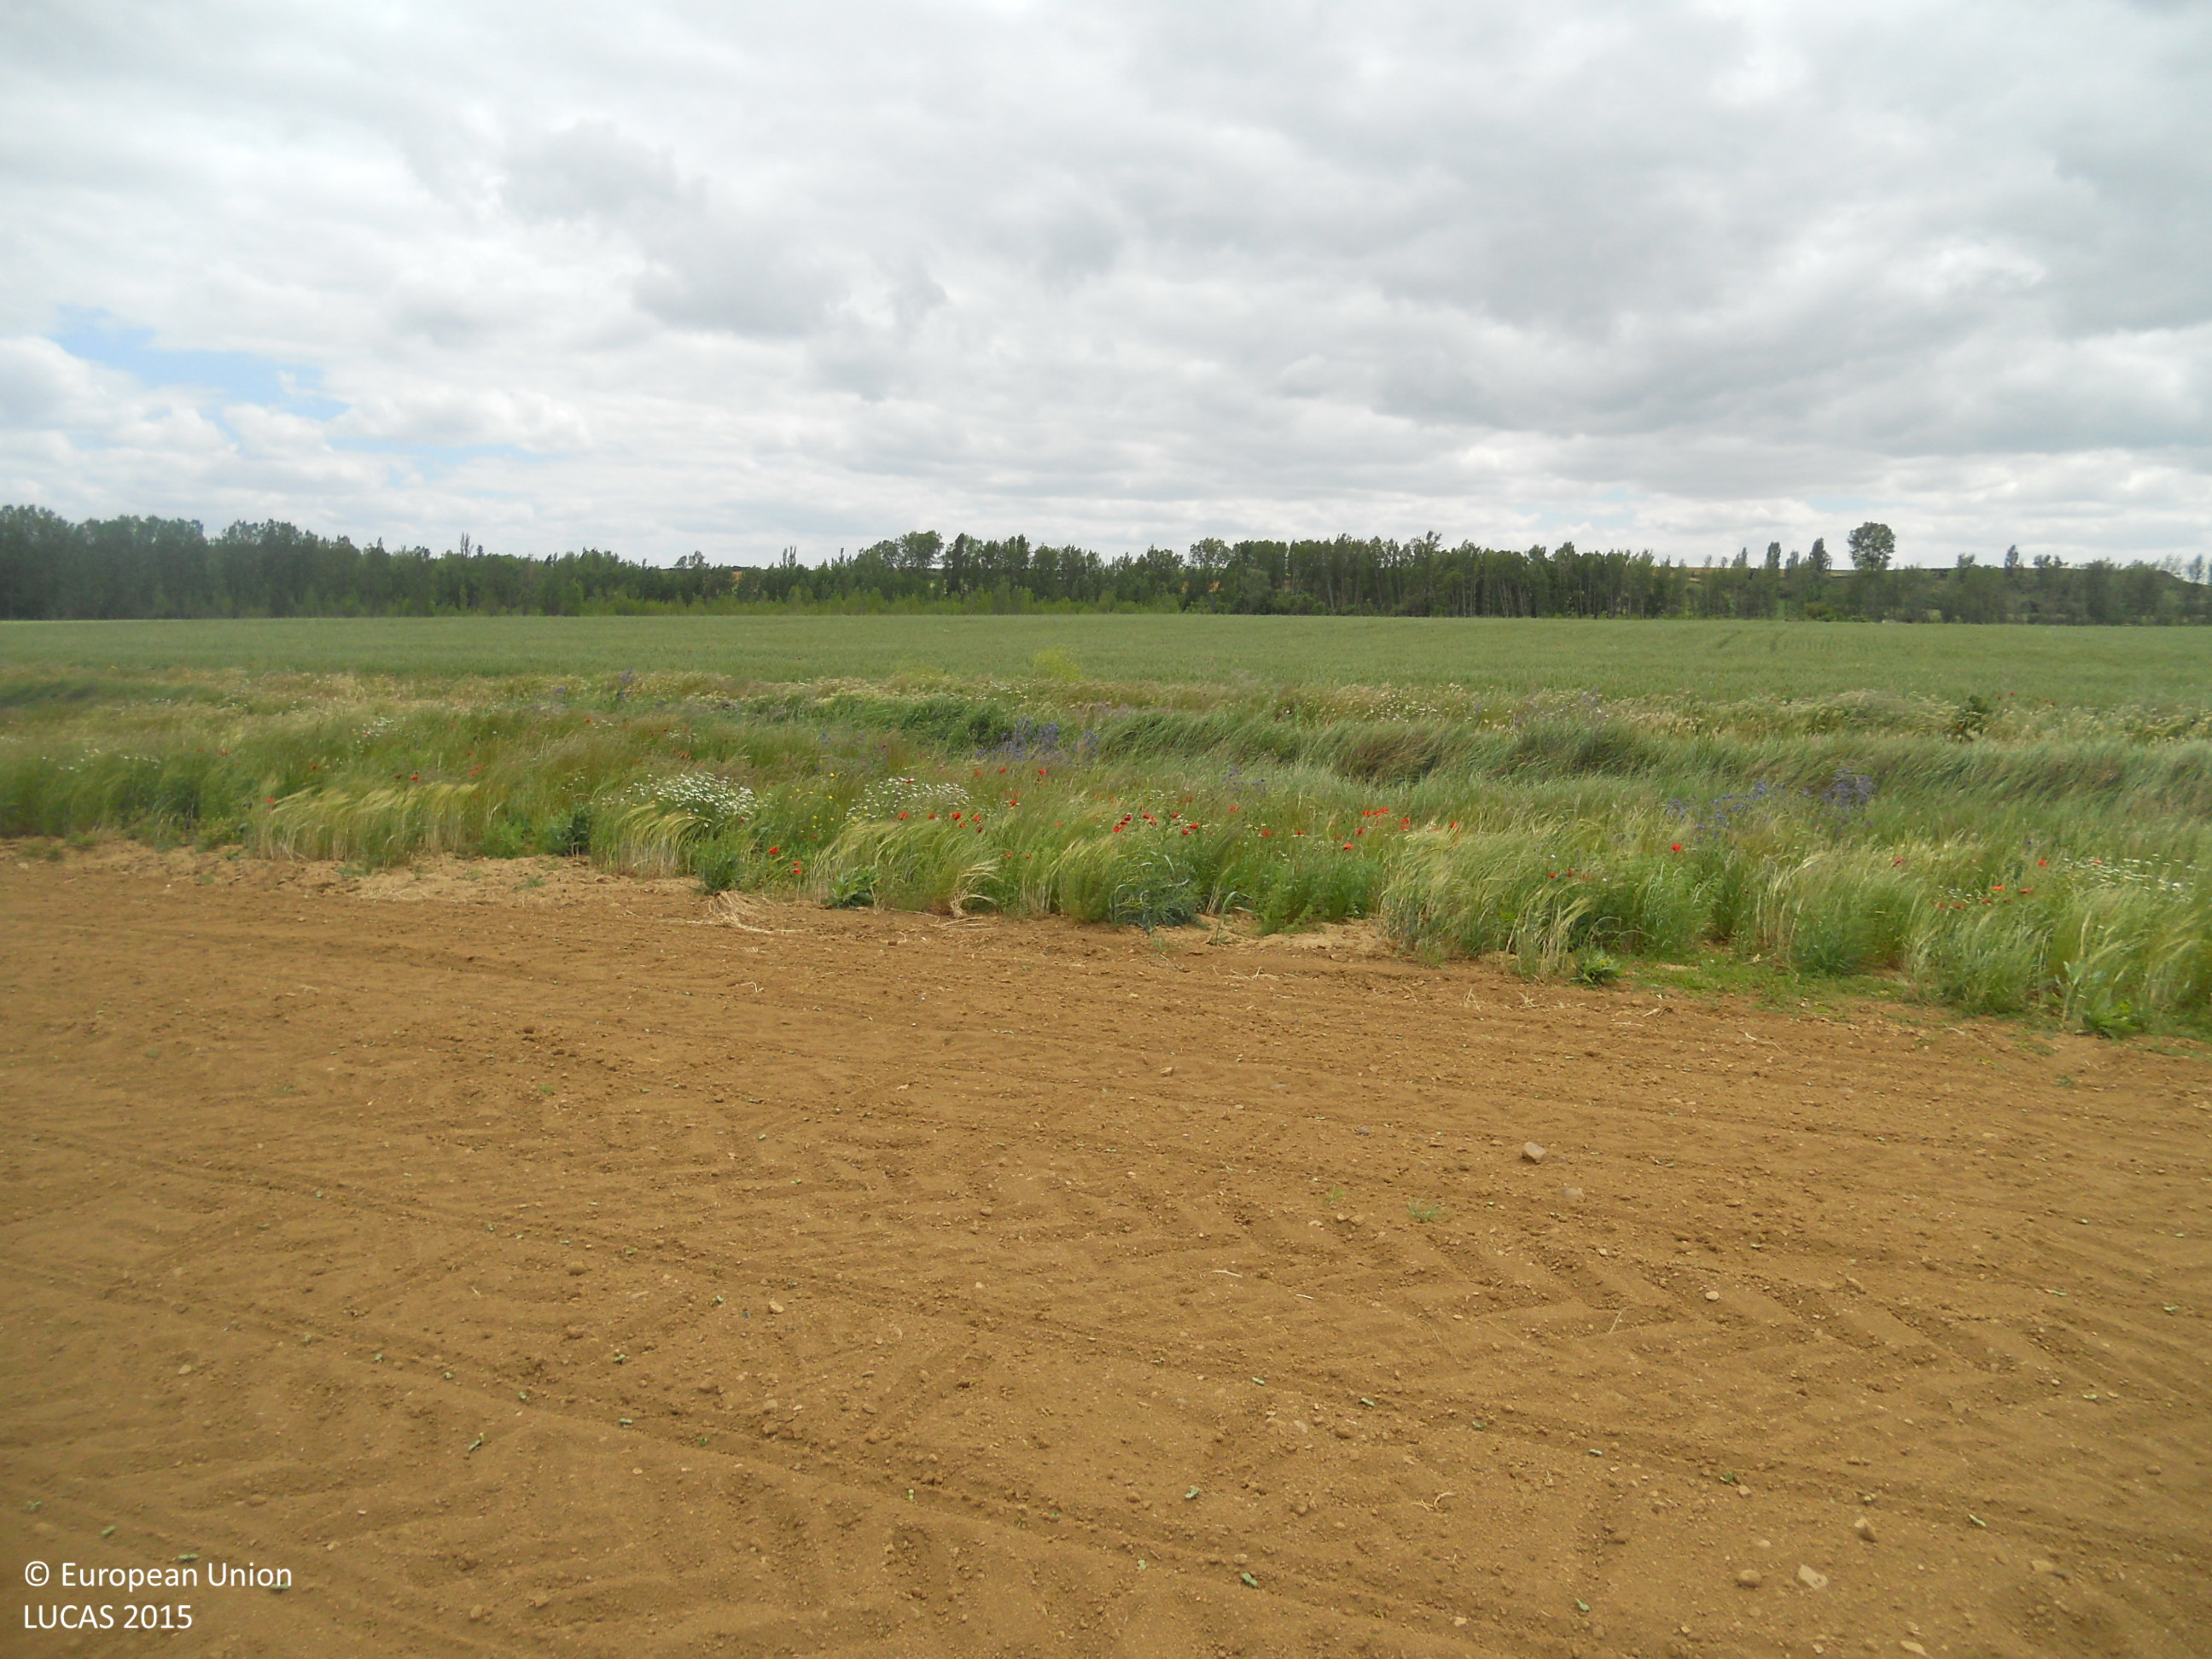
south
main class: Cropland
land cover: Sunflower
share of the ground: < 10 %
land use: Agriculture (excluding fallow land and kitchen gardens)
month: May
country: ES
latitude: 42.4244
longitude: -4.4023
